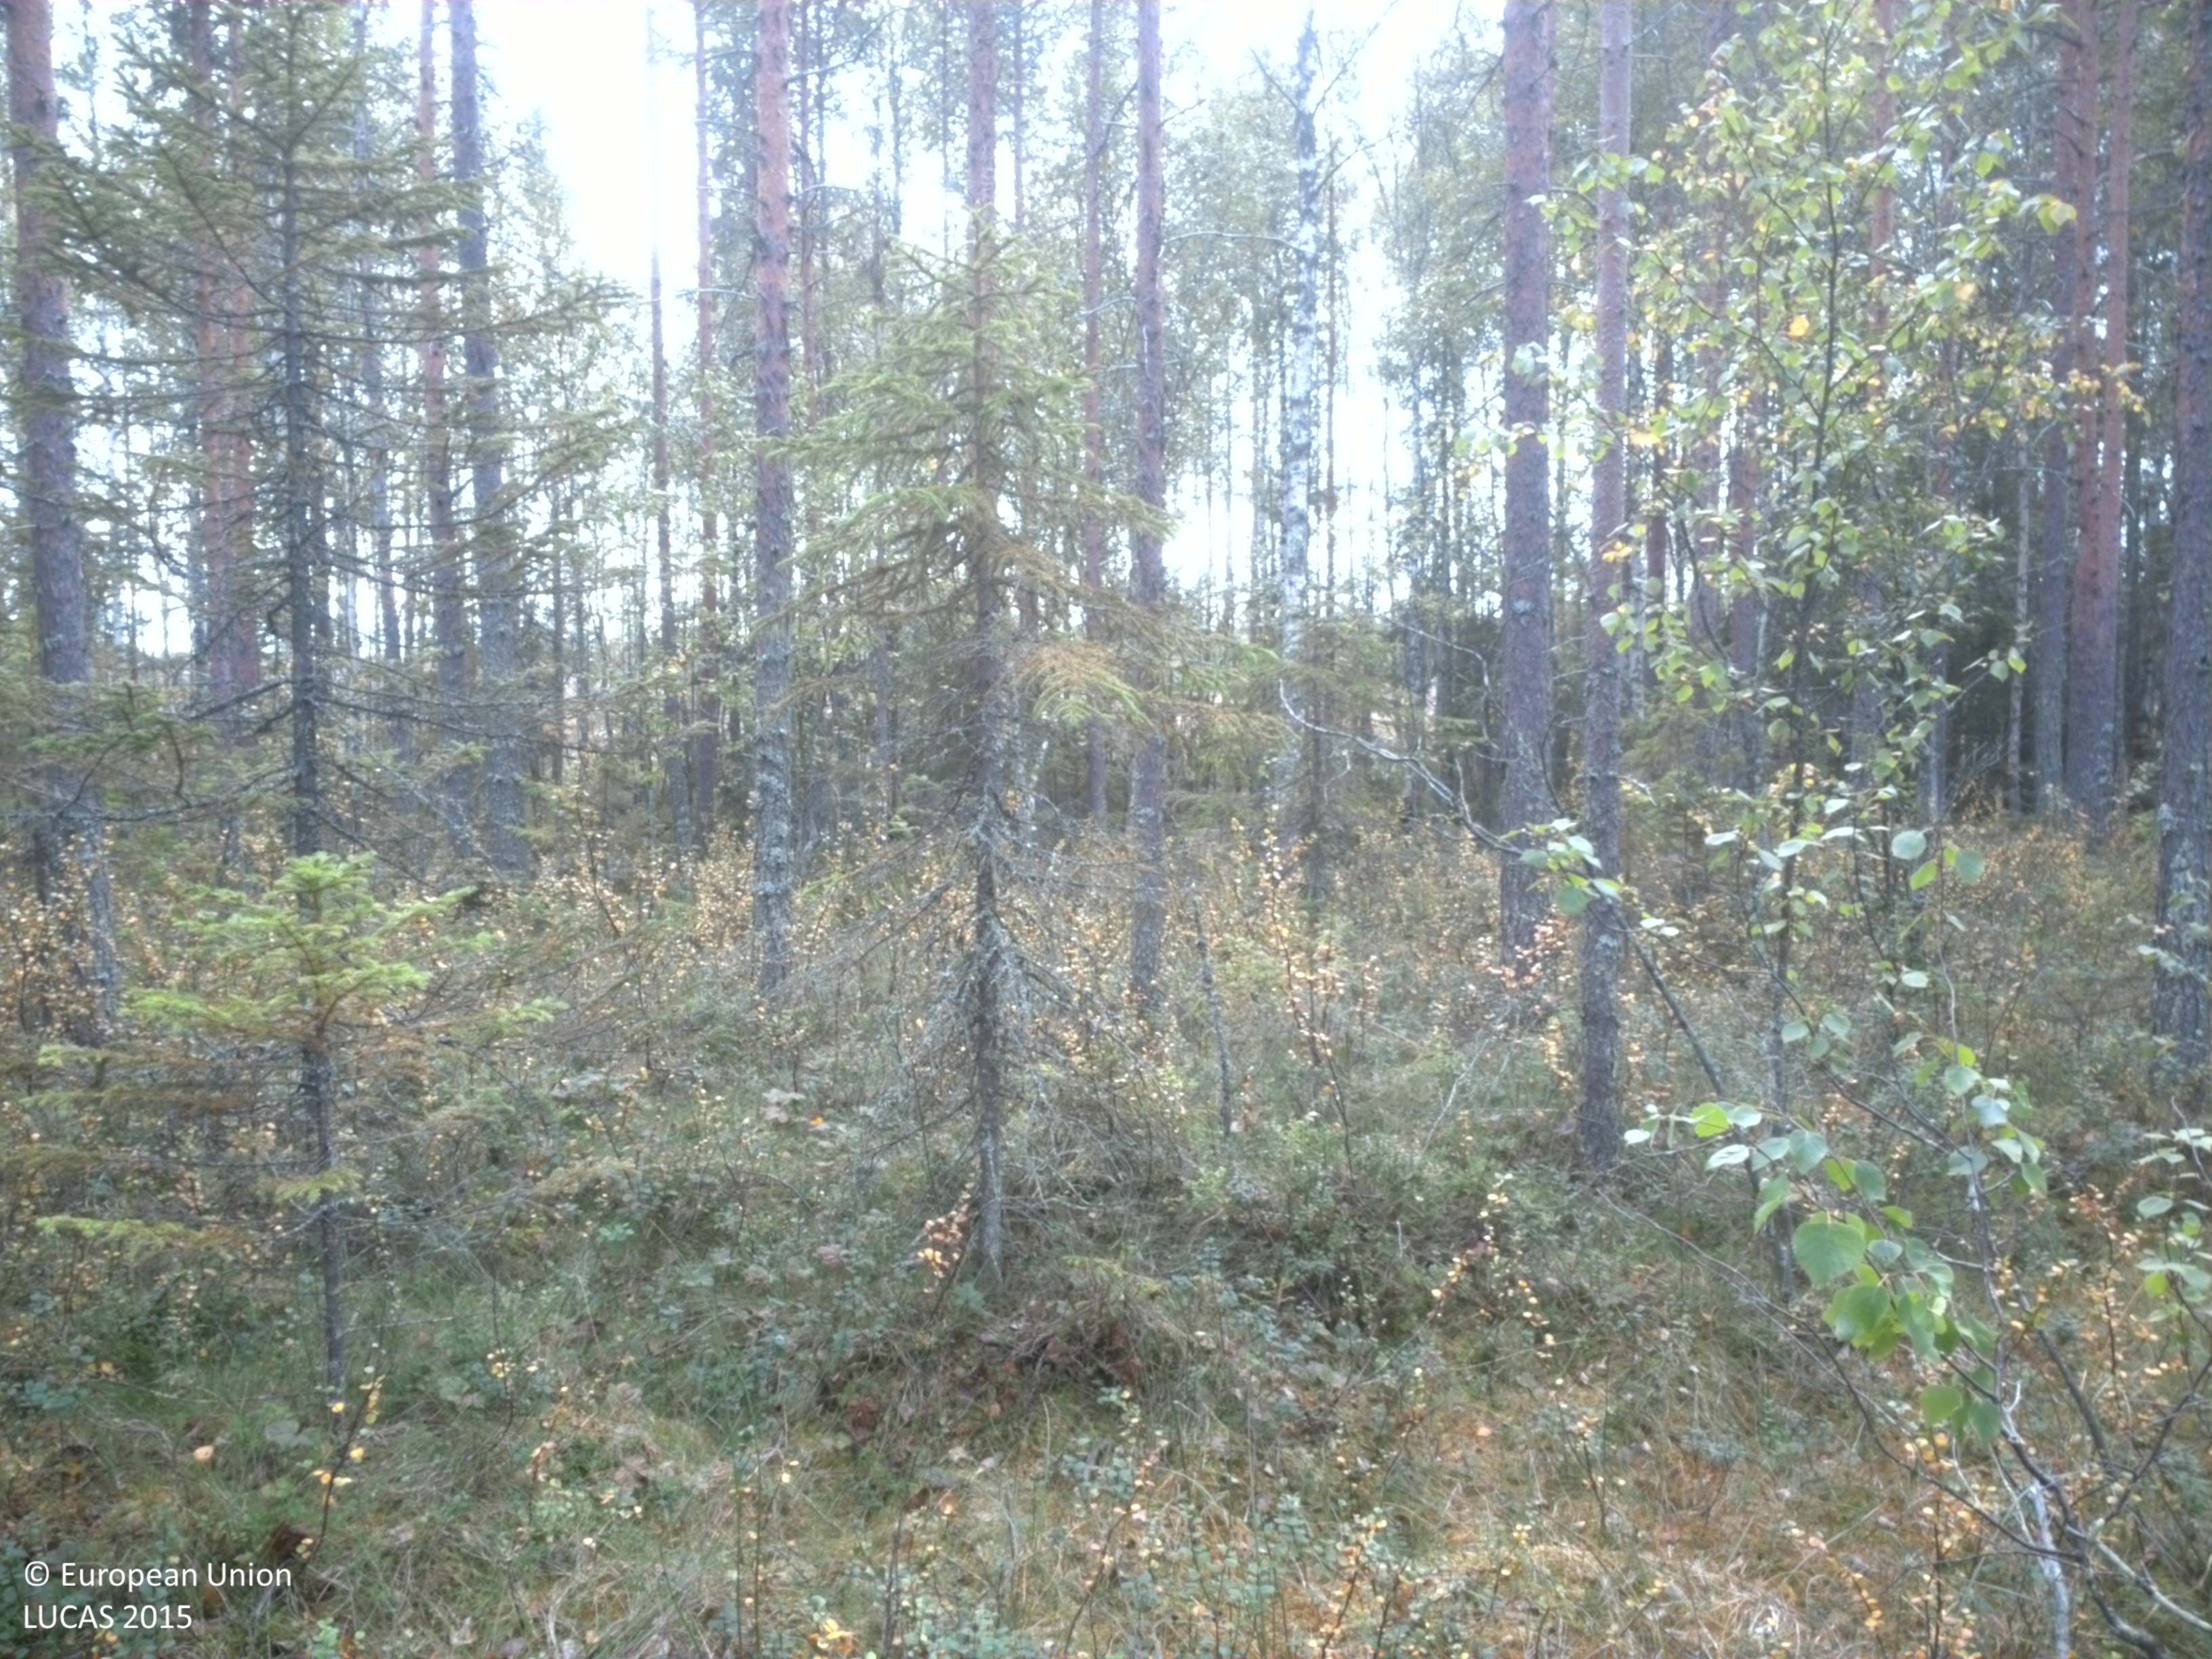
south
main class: Woodland
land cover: Other mixed woodland
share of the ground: 50 - 75 %
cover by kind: coniferous forest trees 25 %, broadleaved forest trees 25 %, herbaceous plants 20 %, lichens and mosses 20 %, shrubs 10 %
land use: Forestry
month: September
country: SE
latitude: 64.5682
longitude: 19.8024
